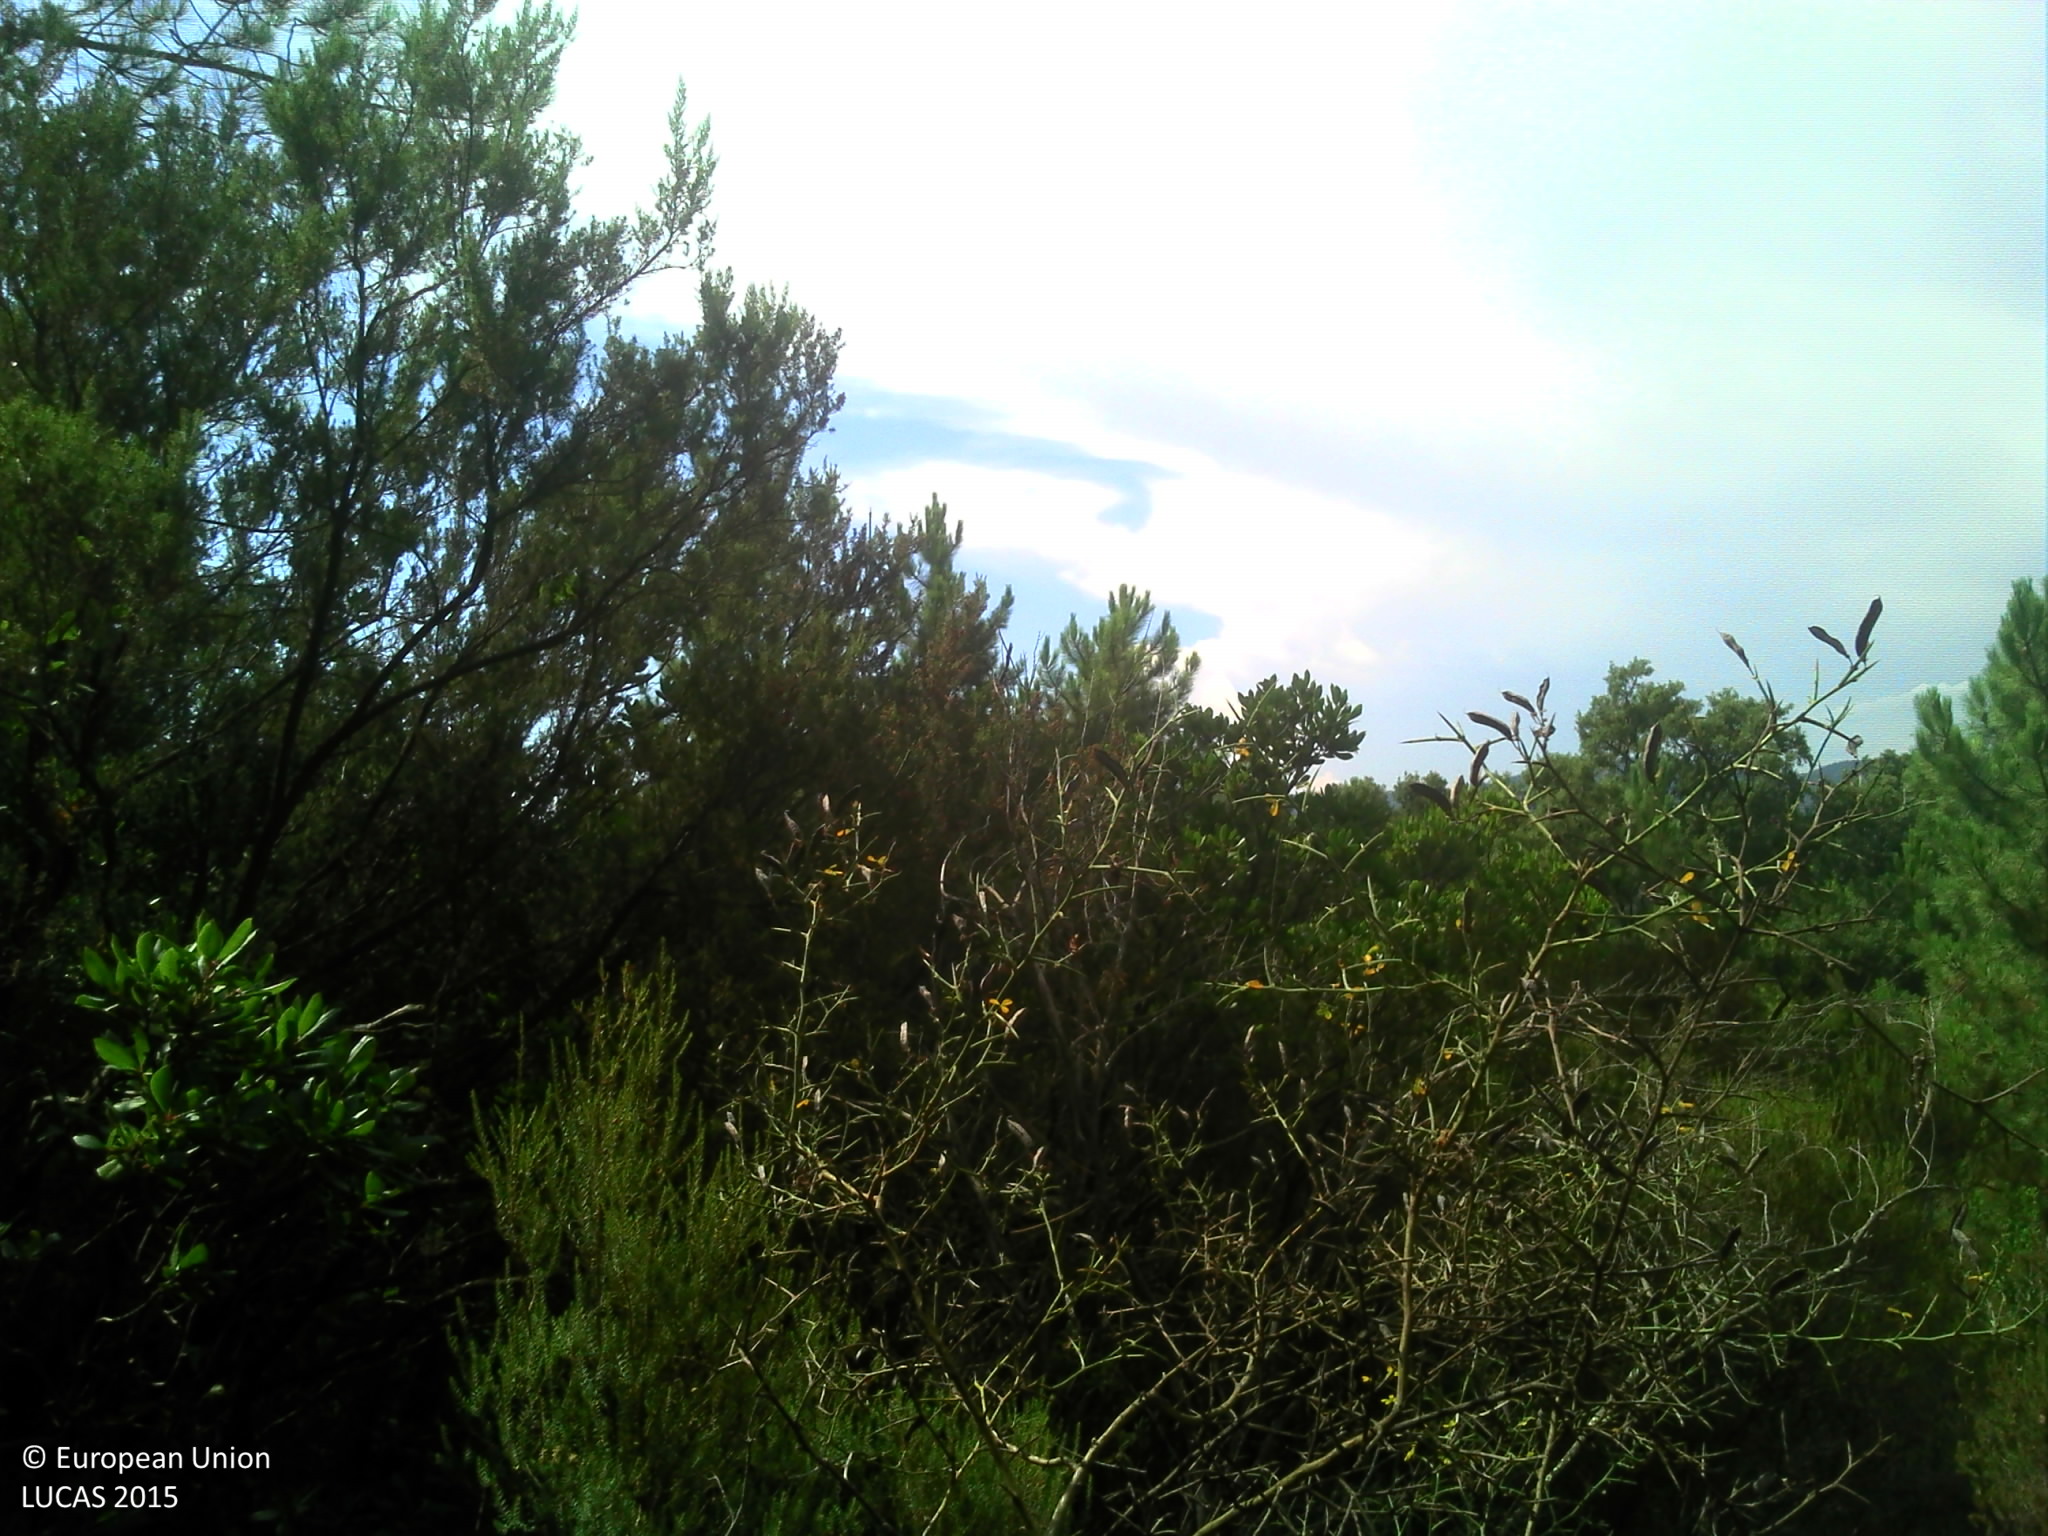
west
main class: Woodland
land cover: Pine dominated mixed woodland
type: coniferous forest of the mediterranean region
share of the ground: > 75 %
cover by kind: coniferous forest trees 50 %, broadleaved forest trees 25 %, shrubs 25 %
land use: Semi-natural and natural areas not in use
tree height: > 5 m
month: July
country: FR
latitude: 43.1866
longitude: 6.4043
